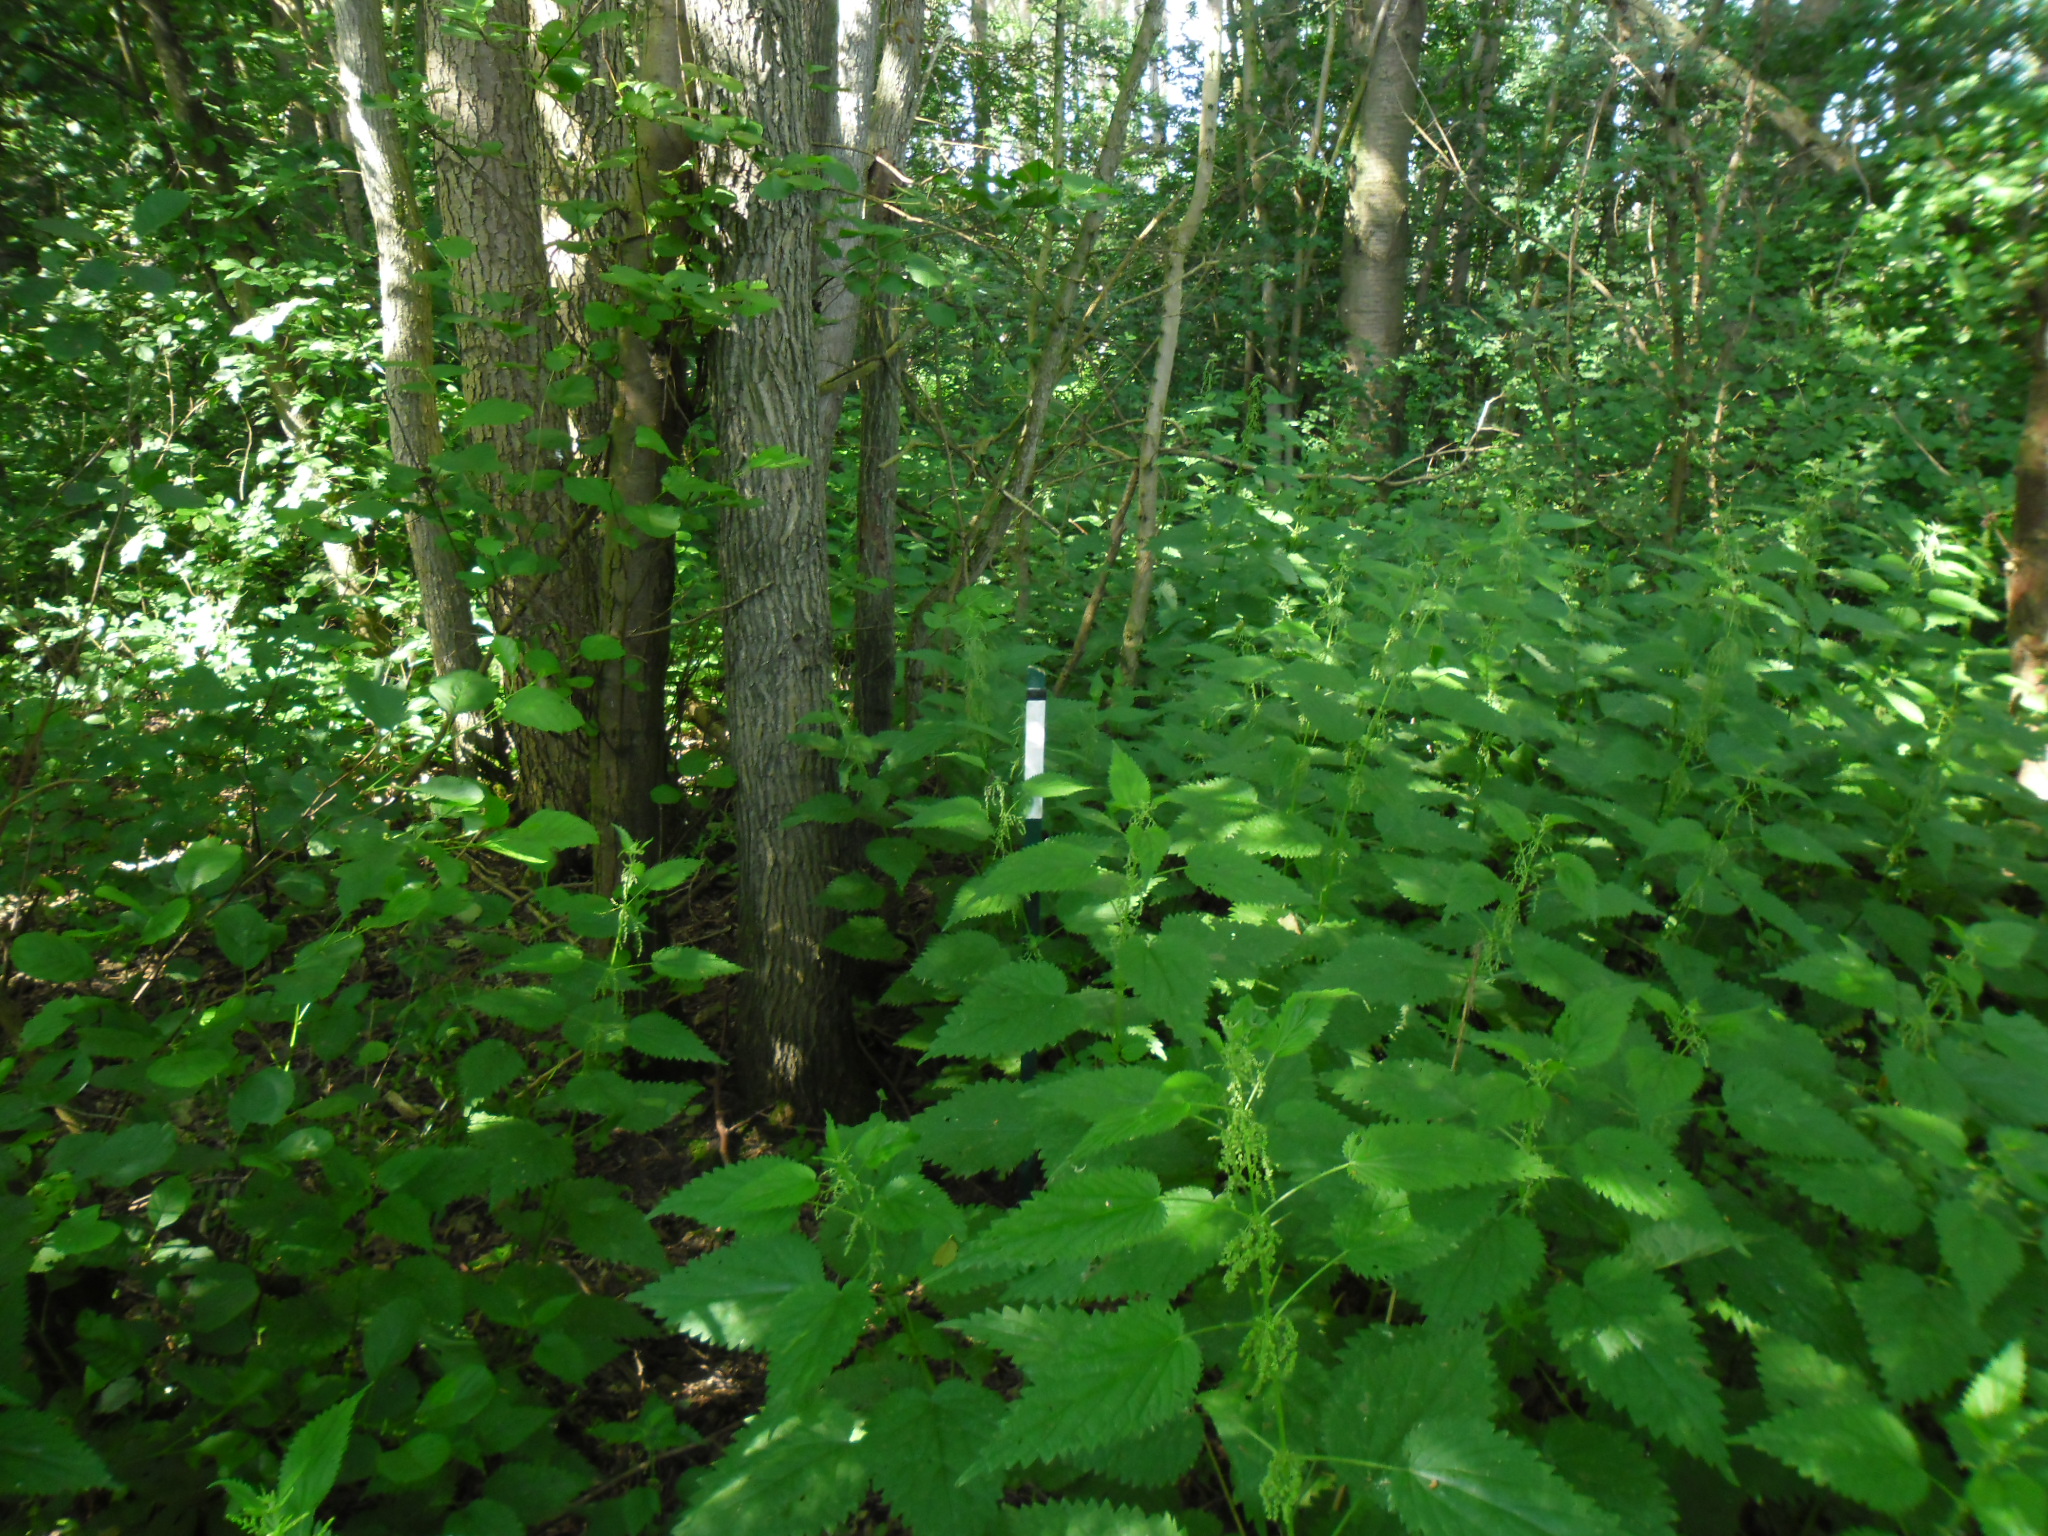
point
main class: Woodland
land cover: Broadleaved woodland
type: mesophytic deciduous forest
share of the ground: > 75 %
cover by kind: broadleaved forest trees 100 %
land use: Semi-natural and natural areas not in use
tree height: > 5 m
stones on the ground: < 10 %
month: June
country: NL
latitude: 52.6036
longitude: 5.6429
